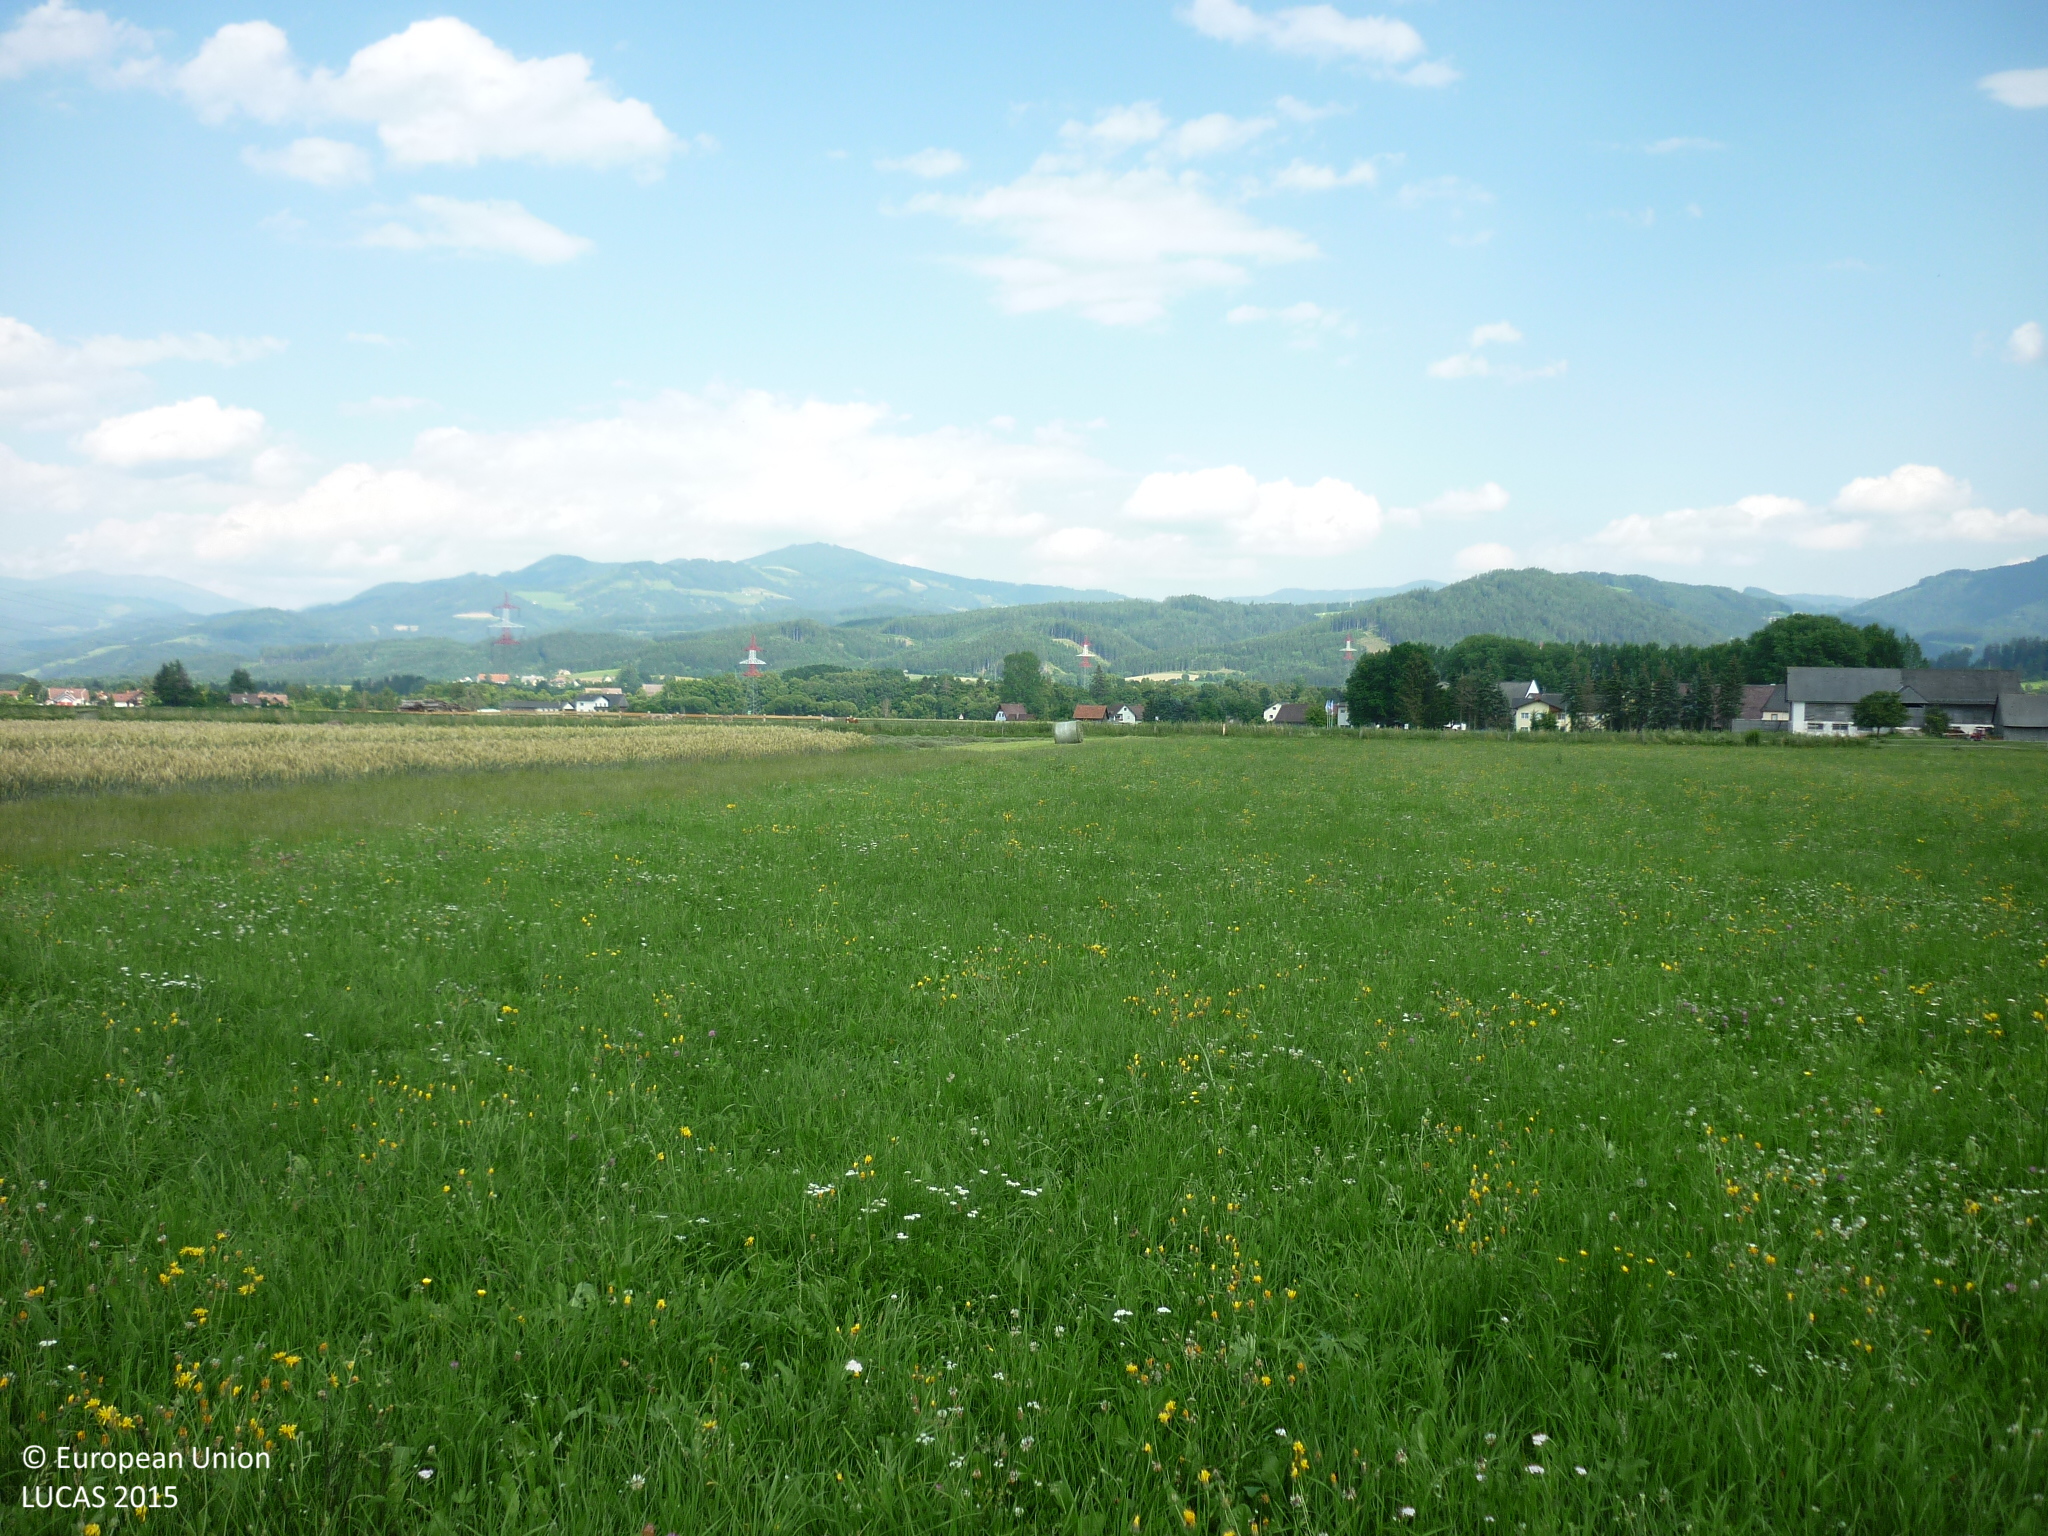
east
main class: Grassland
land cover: Grassland without tree/shrub cover
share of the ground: > 75 %
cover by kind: herbaceous plants 100 %
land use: Agriculture (excluding fallow land and kitchen gardens)
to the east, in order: Grassland without tree/shrub cover; Paved roads, cycling and walking lanes; Dry pulses; Grass margins; Fences; Grassland without tree/shrub cover; Fences; Grassland without tree/shrub cover
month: July
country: AT
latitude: 47.1663
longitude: 14.7348
